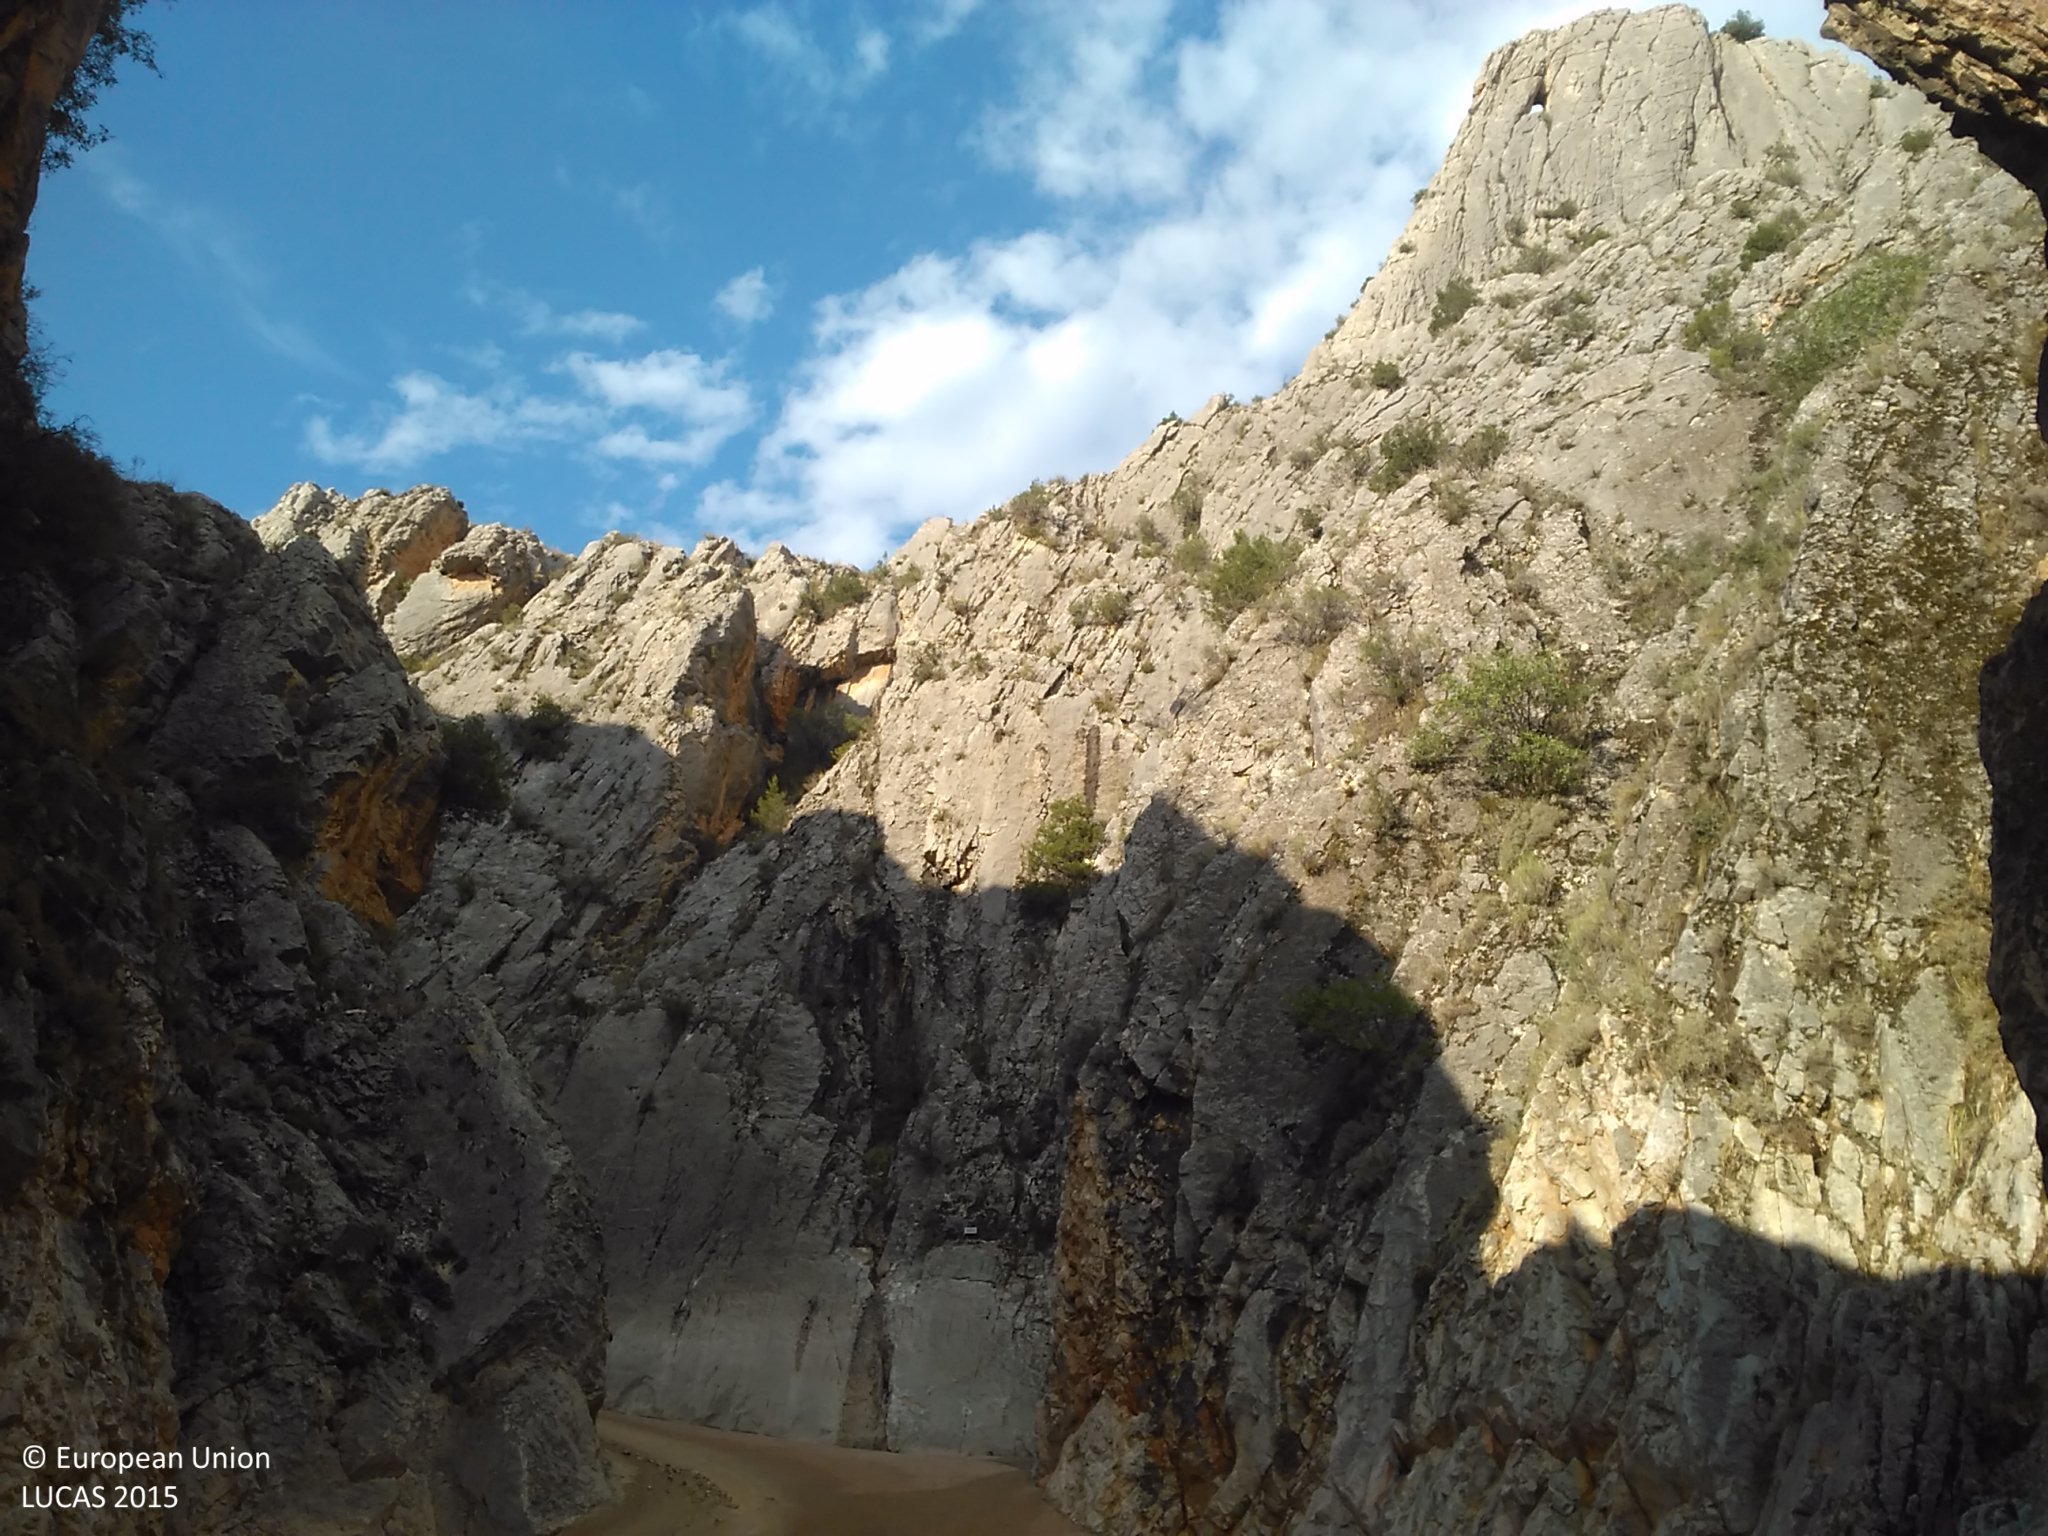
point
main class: Shrubland
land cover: Shrubland without tree cover
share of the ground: 10 - 25 %
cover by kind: unconsolidated bare surface 80 %, shrubs 20 %
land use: Semi-natural and natural areas not in use
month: July
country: ES
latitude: 41.3962
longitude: -1.9532
